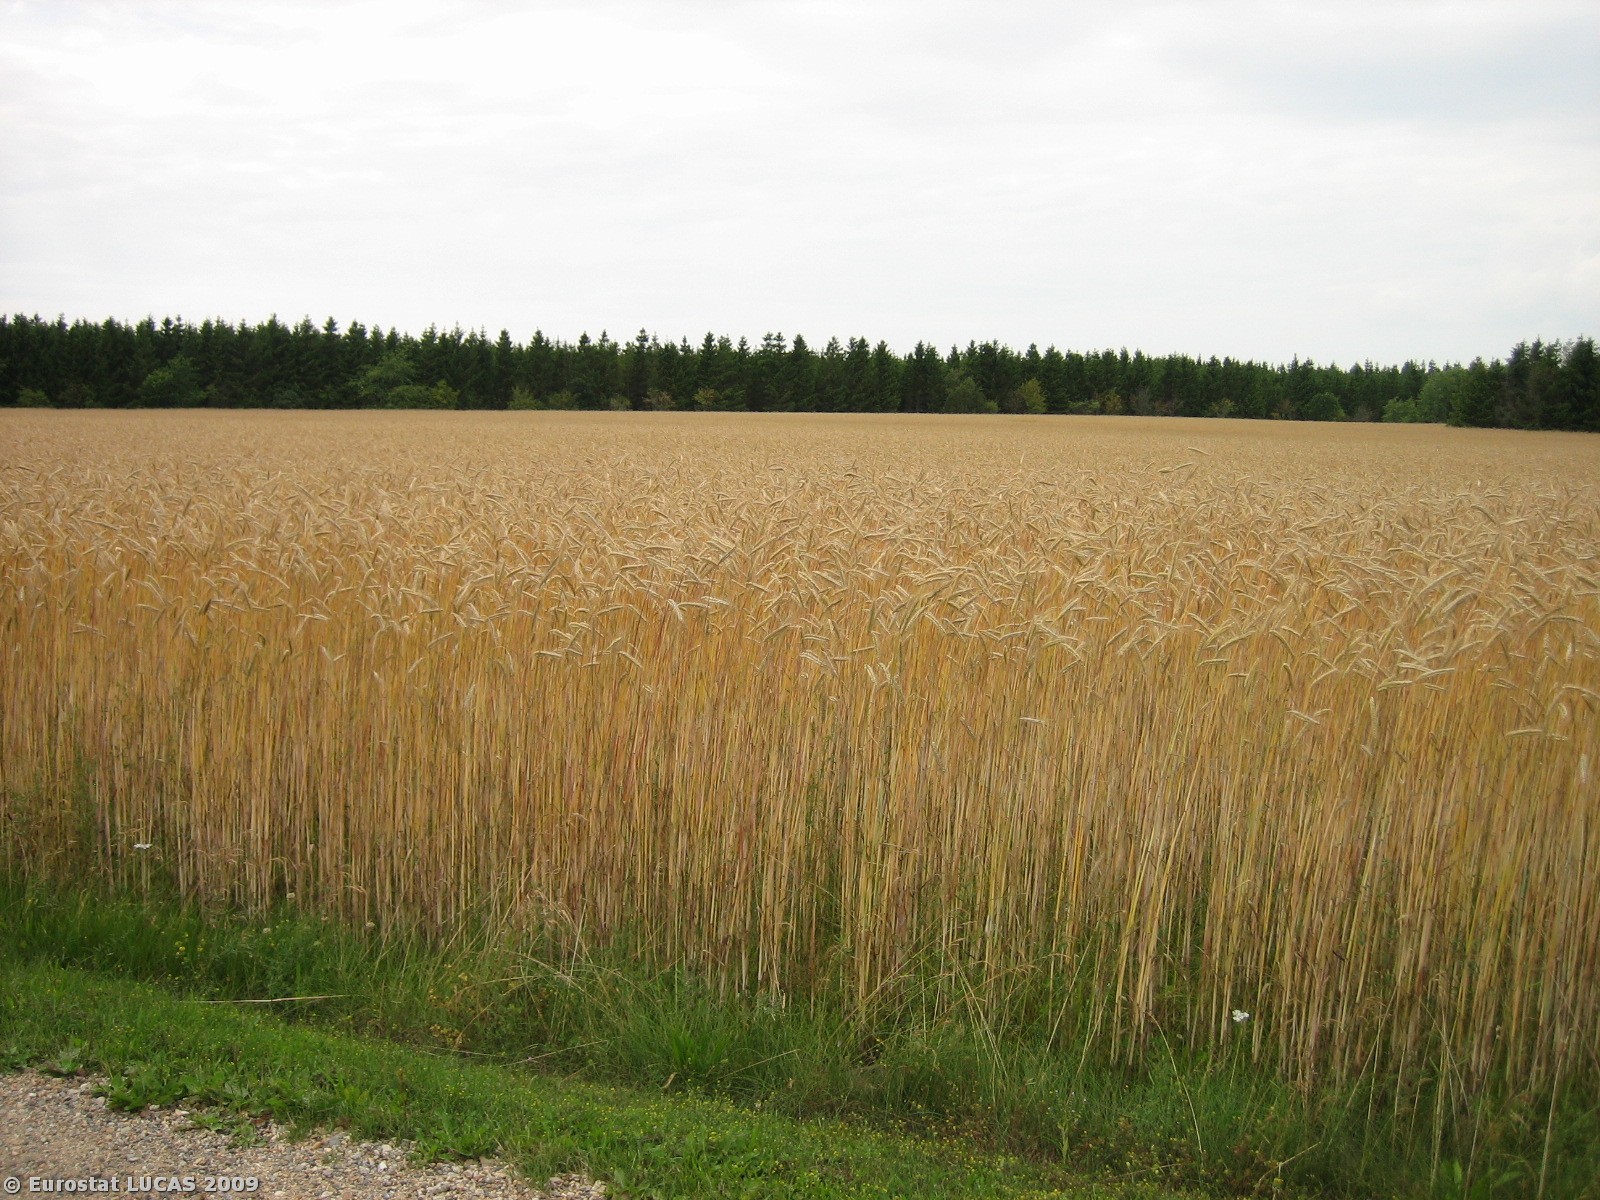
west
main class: Cropland
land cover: Rye
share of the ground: > 75 %
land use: Agriculture (excluding fallow land and kitchen gardens)
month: July
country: DK
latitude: 55.8580
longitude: 8.7392
